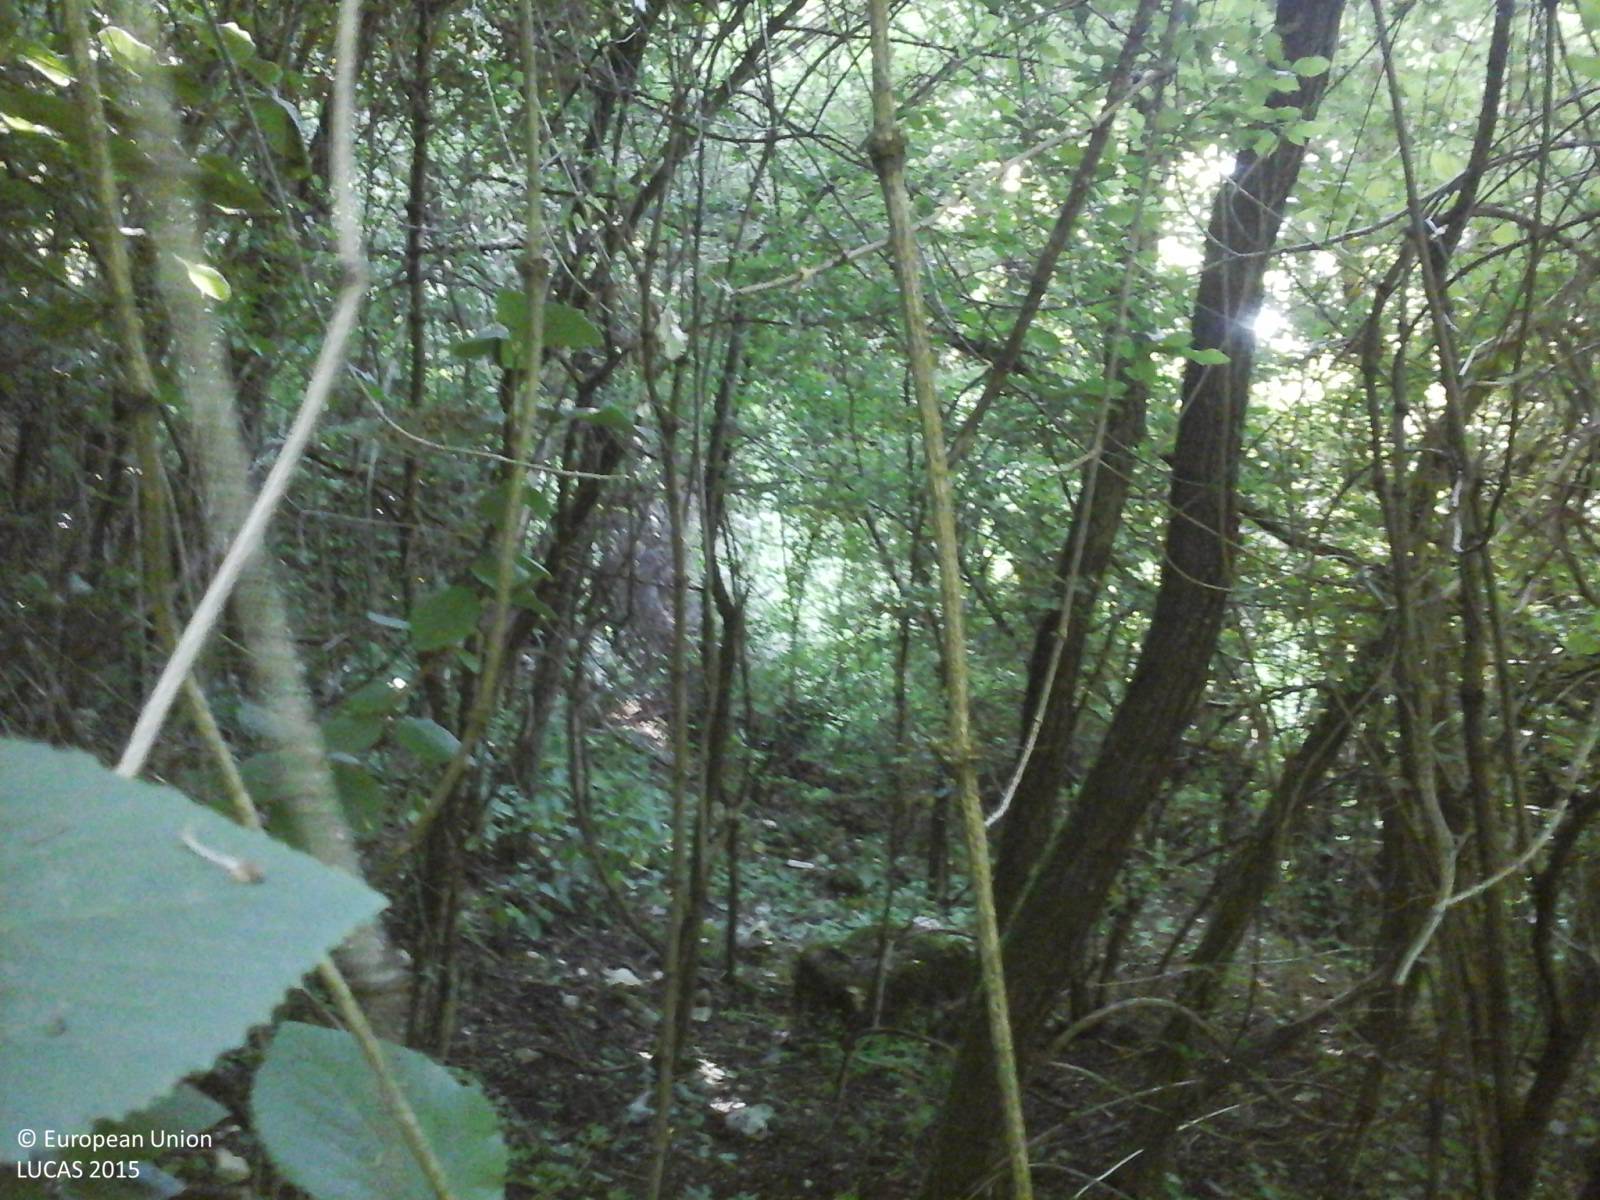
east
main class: Woodland
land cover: Broadleaved woodland
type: thermophilous deciduous forest
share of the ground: > 75 %
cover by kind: broadleaved forest trees 70 %, shrubs 30 %
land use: Semi-natural and natural areas not in use
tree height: > 5 m
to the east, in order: Broadleaved woodland; Grass margins; Paved roads, cycling and walking lanes; Grass margins; Broadleaved woodland
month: July
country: IT
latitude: 42.4036
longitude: 13.2336
